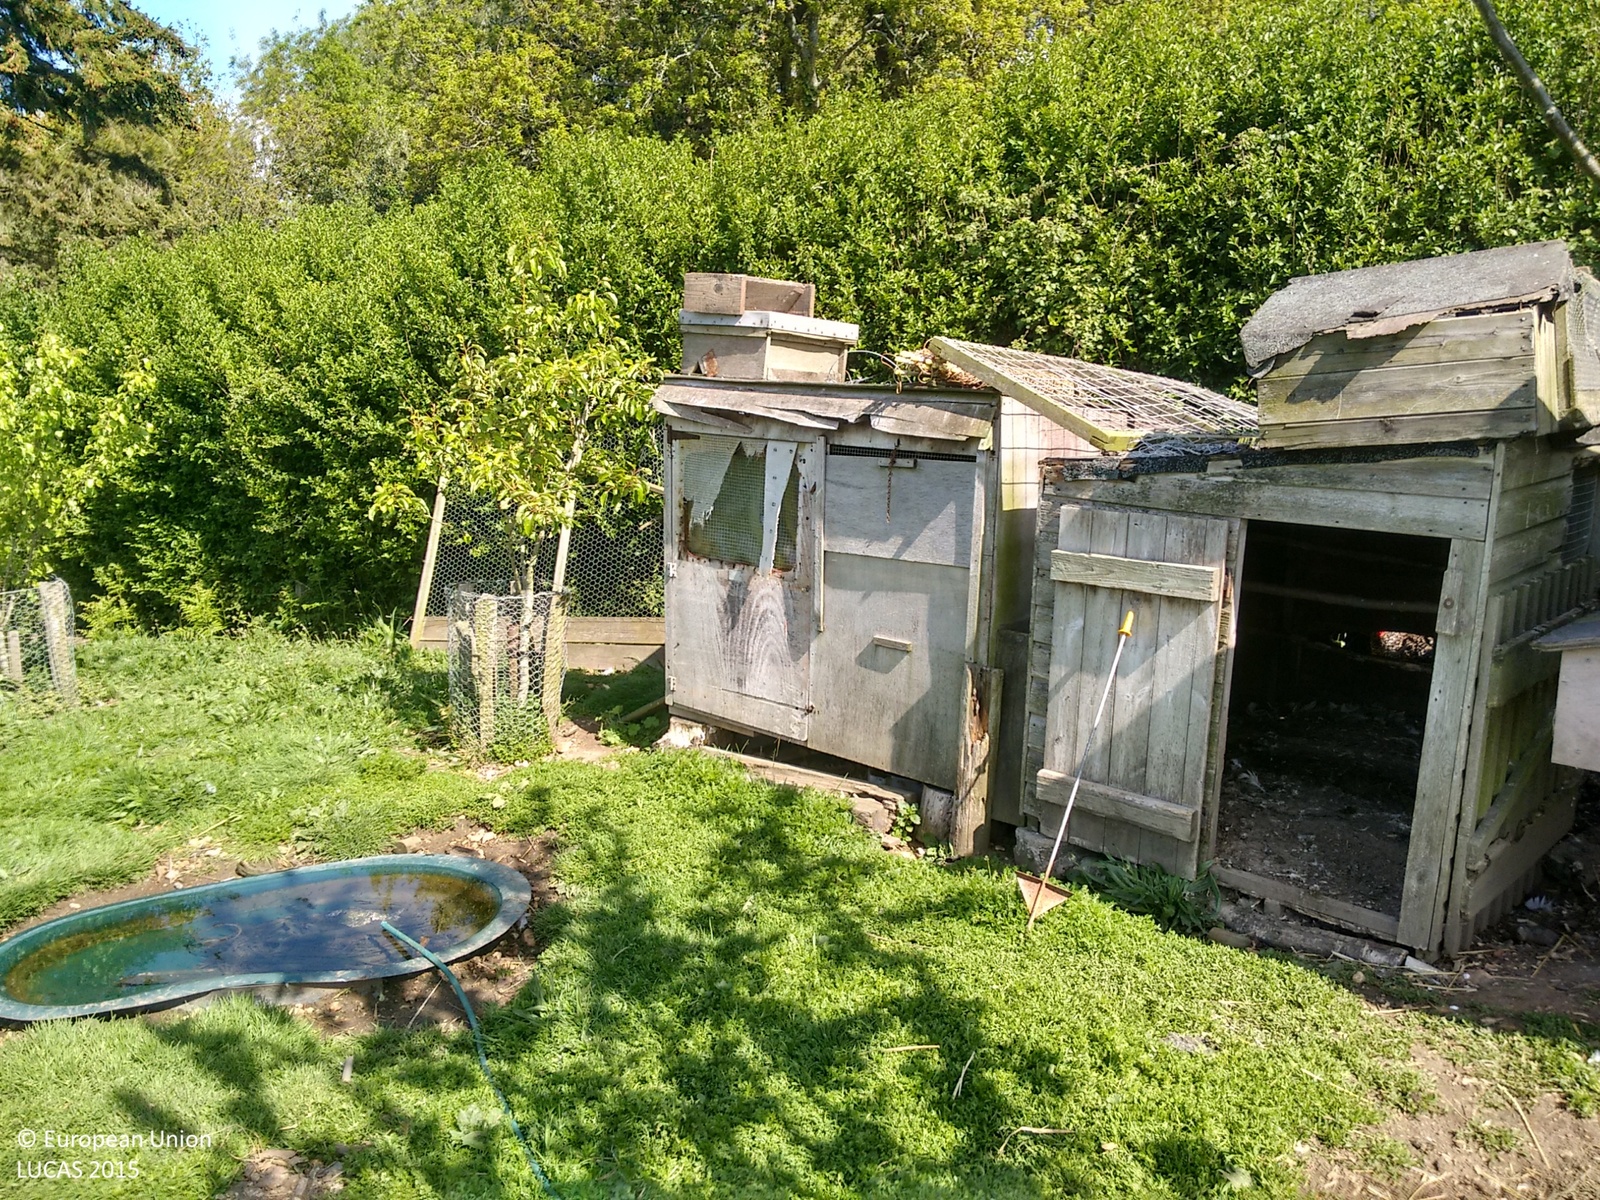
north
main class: Grassland
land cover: Grassland with sparse tree/shrub cover
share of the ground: > 75 %
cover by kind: herbaceous plants 95 %, broadleaved forest trees 5 %
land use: Agriculture (excluding fallow land and kitchen gardens)
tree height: < 5 m
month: May
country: GB
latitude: 50.6851
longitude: -2.2484
